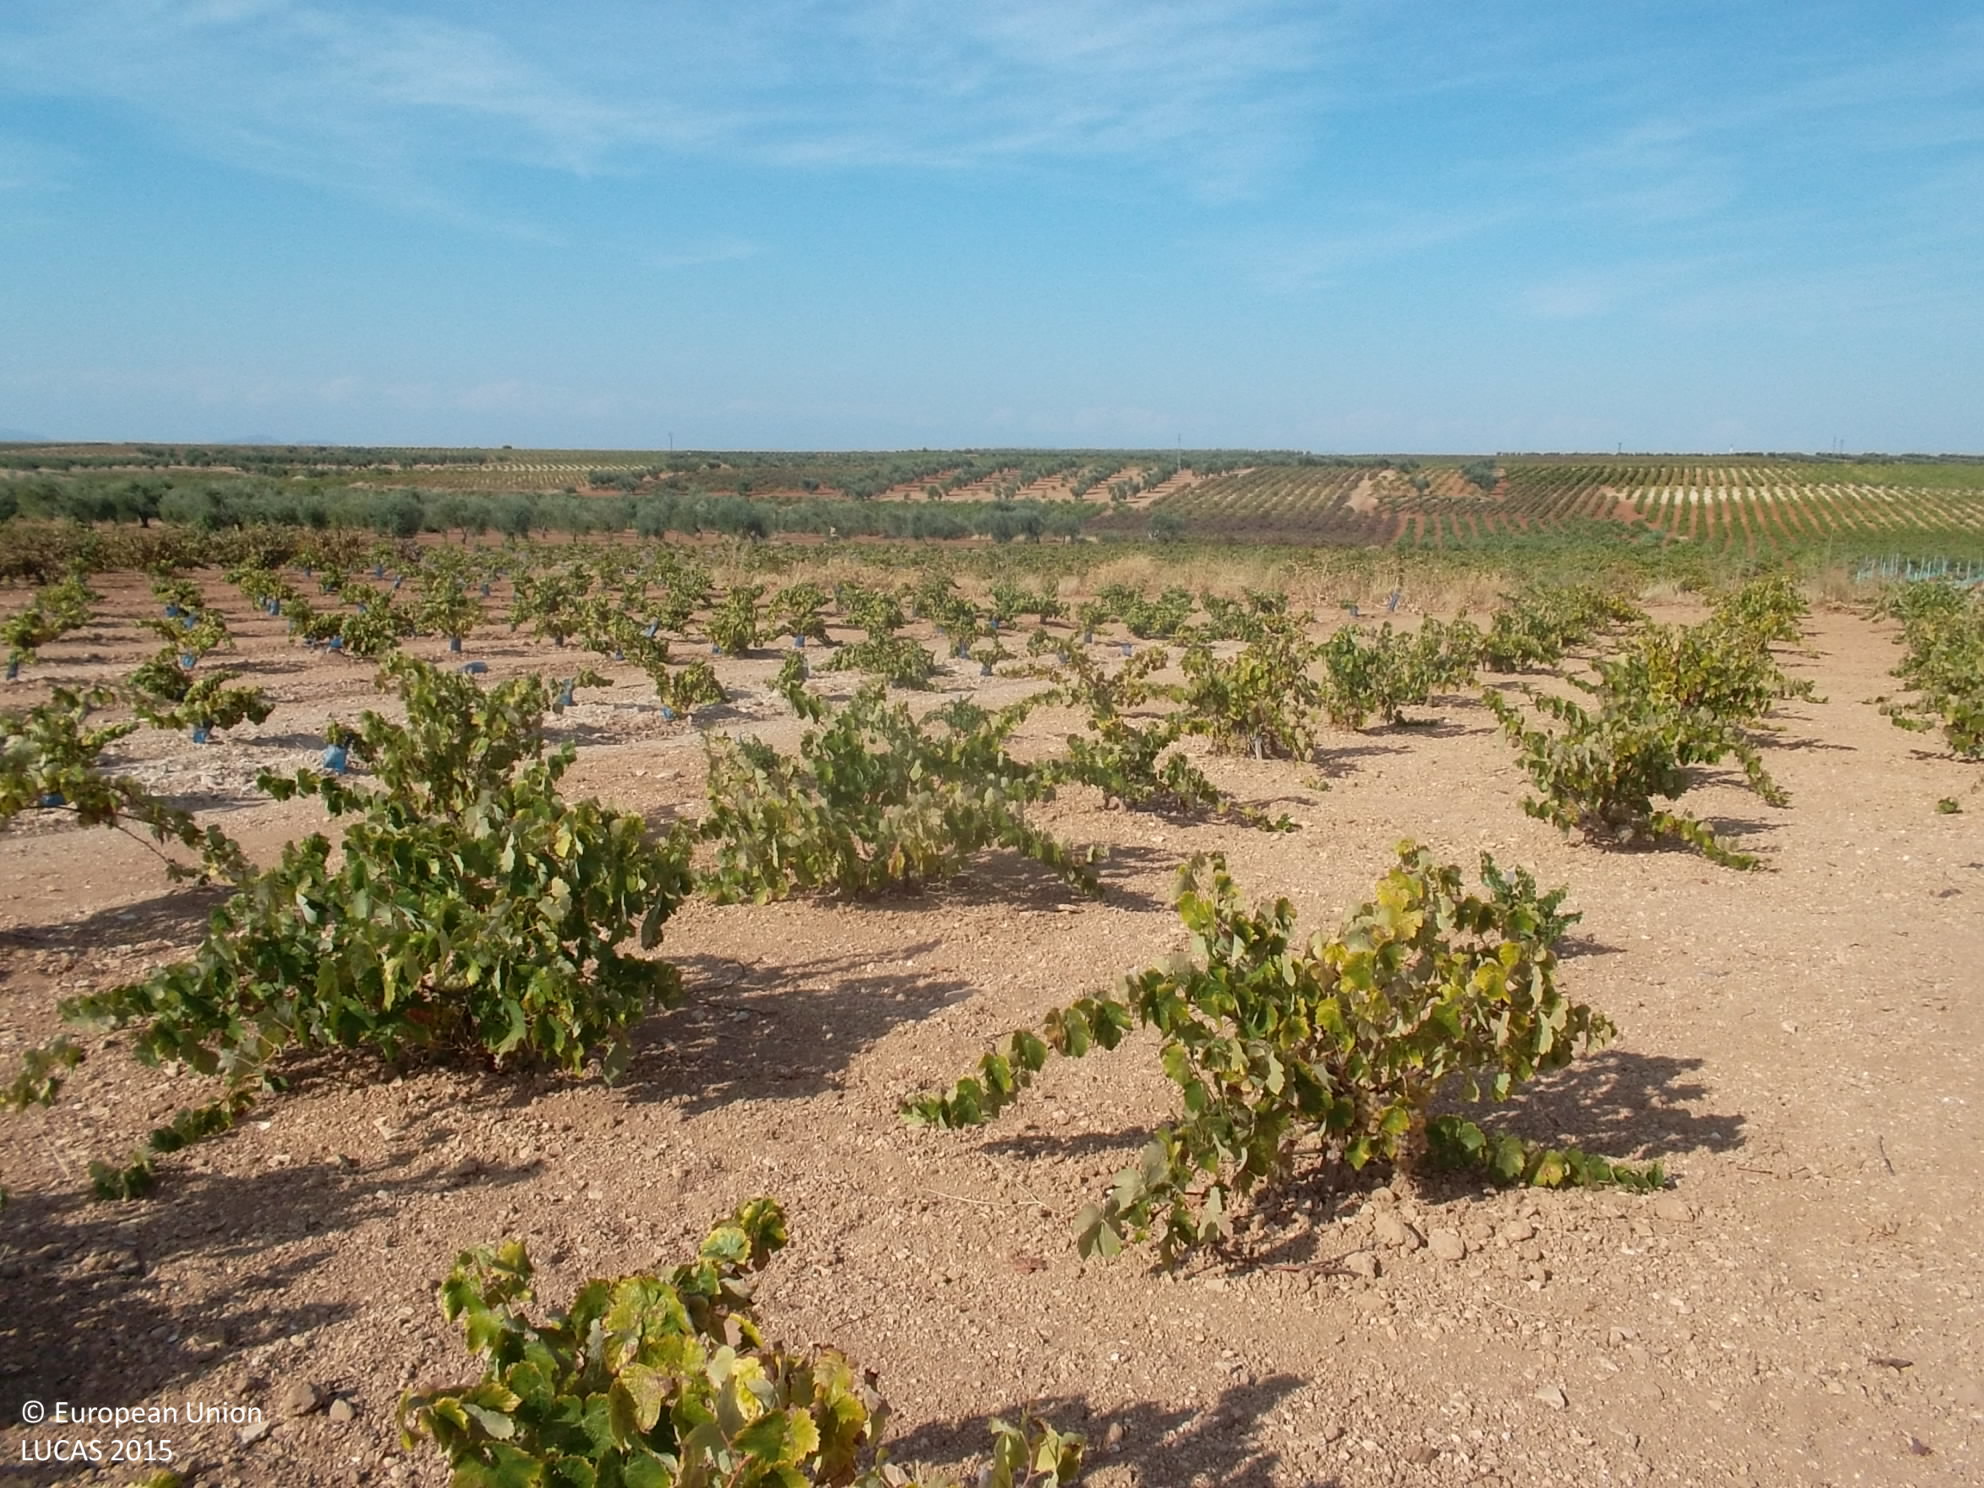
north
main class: Cropland
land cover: Vineyards
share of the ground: 25 - 50 %
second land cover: Other bare soil
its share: > 75 %
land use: Agriculture (excluding fallow land and kitchen gardens)
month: September
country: ES
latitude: 38.5485
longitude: -6.3795
